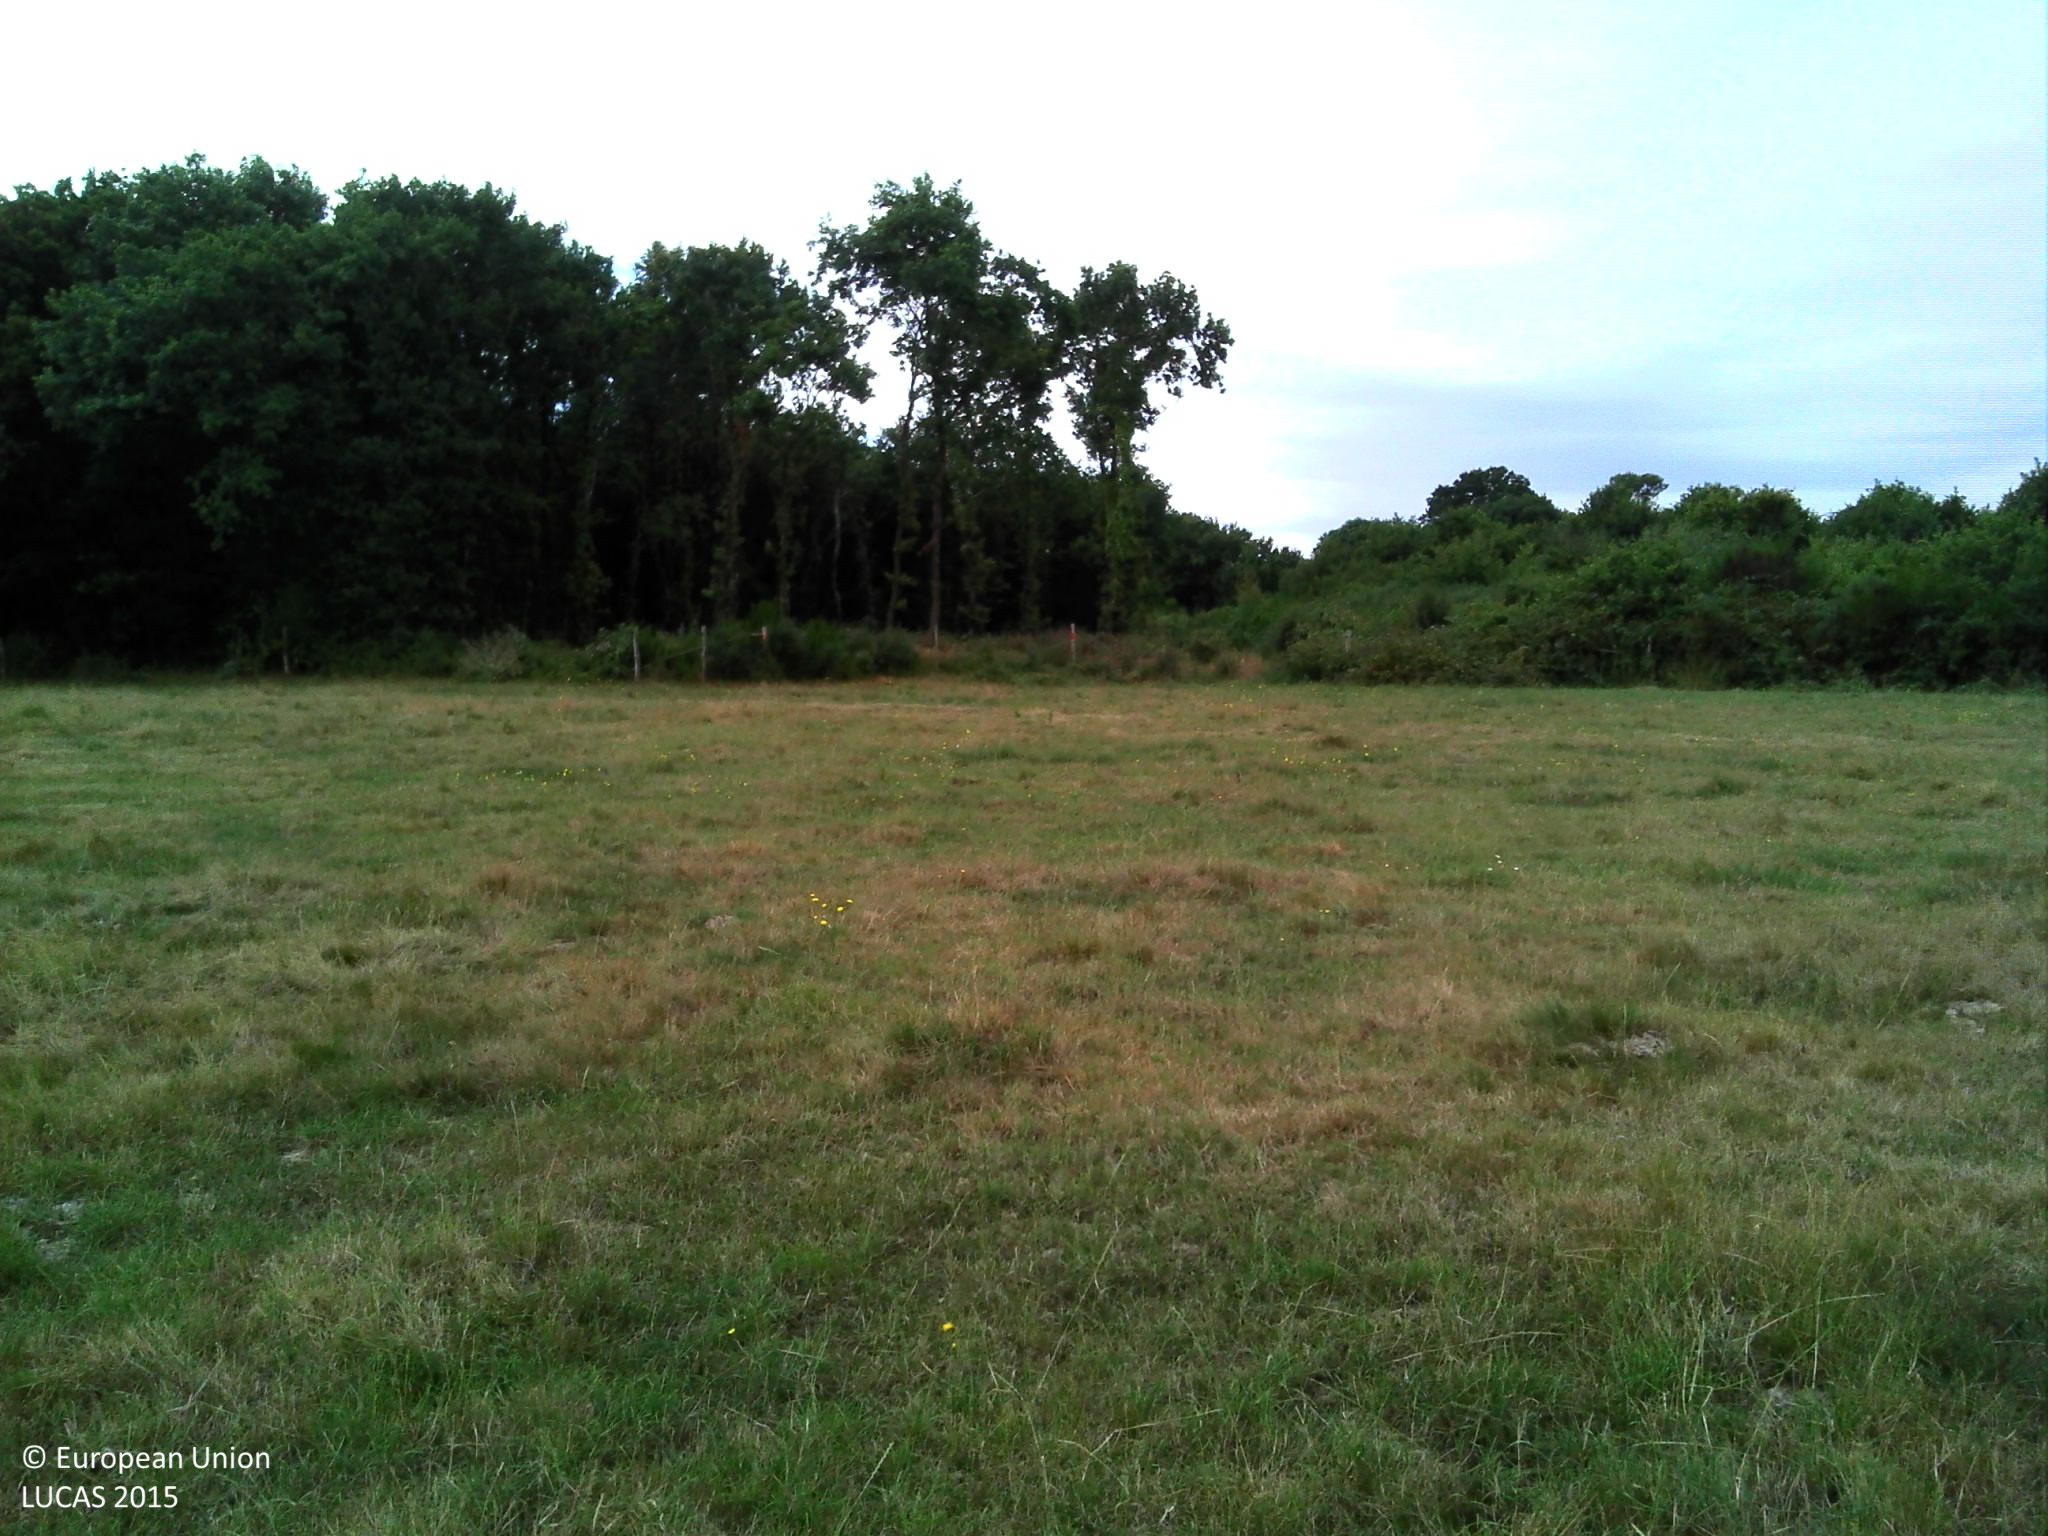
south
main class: Cropland
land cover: Temporary grasslands
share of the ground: > 75 %
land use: Agriculture (excluding fallow land and kitchen gardens)
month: July
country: FR
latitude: 47.4770
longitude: -2.1399
